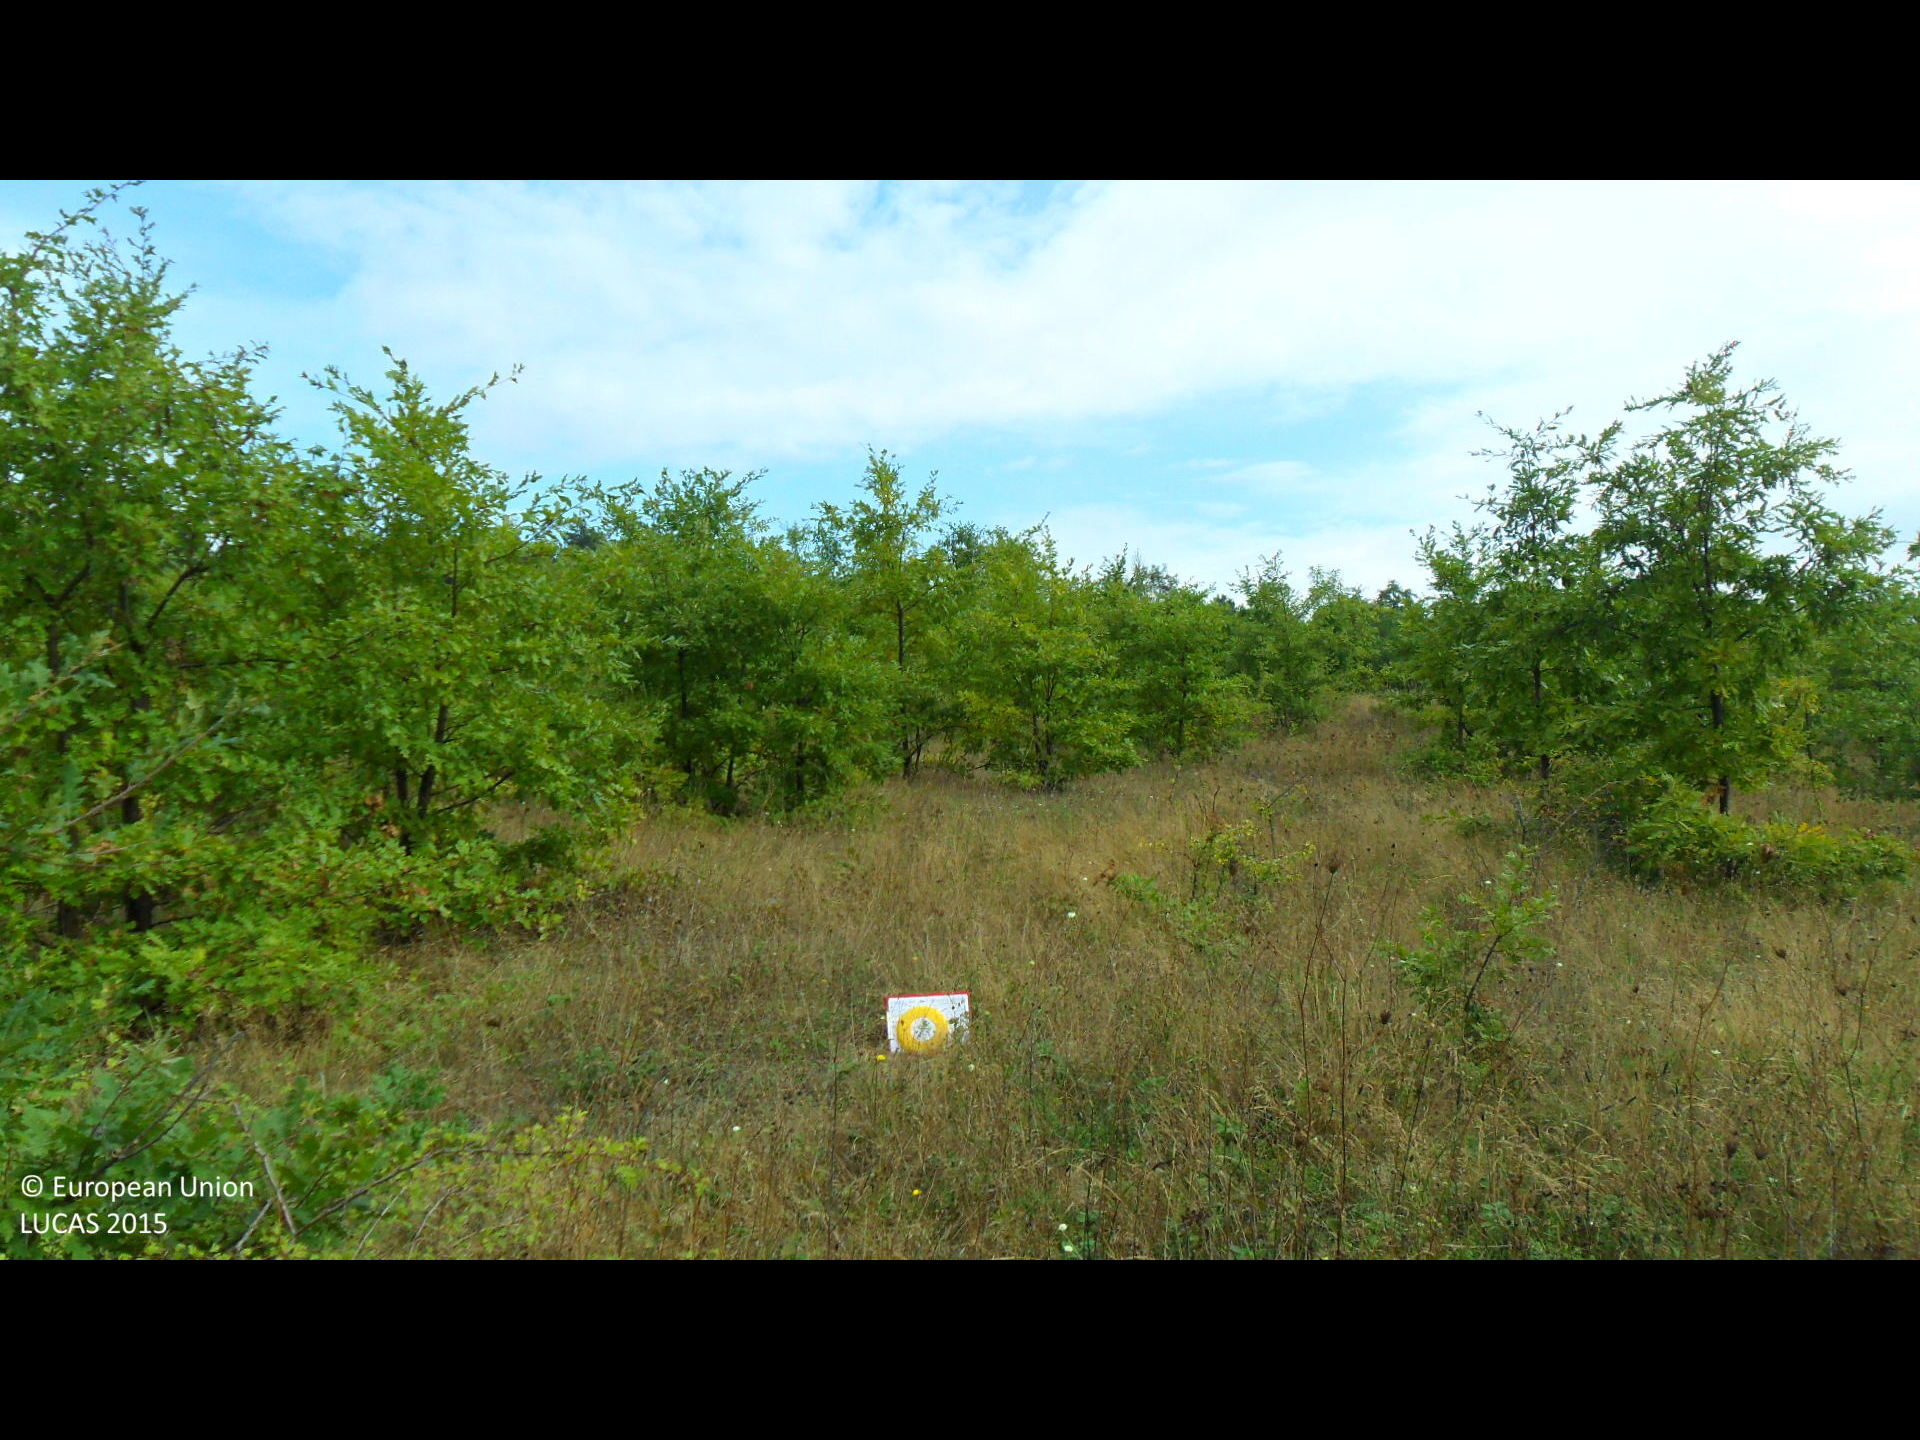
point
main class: Grassland
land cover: Grassland with sparse tree/shrub cover
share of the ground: > 75 %
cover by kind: herbaceous plants 90 %, broadleaved forest trees 5 %, shrubs 5 %
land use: Agriculture (excluding fallow land and kitchen gardens)
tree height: < 5 m
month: September
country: BG
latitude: 43.0863
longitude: 26.4232
